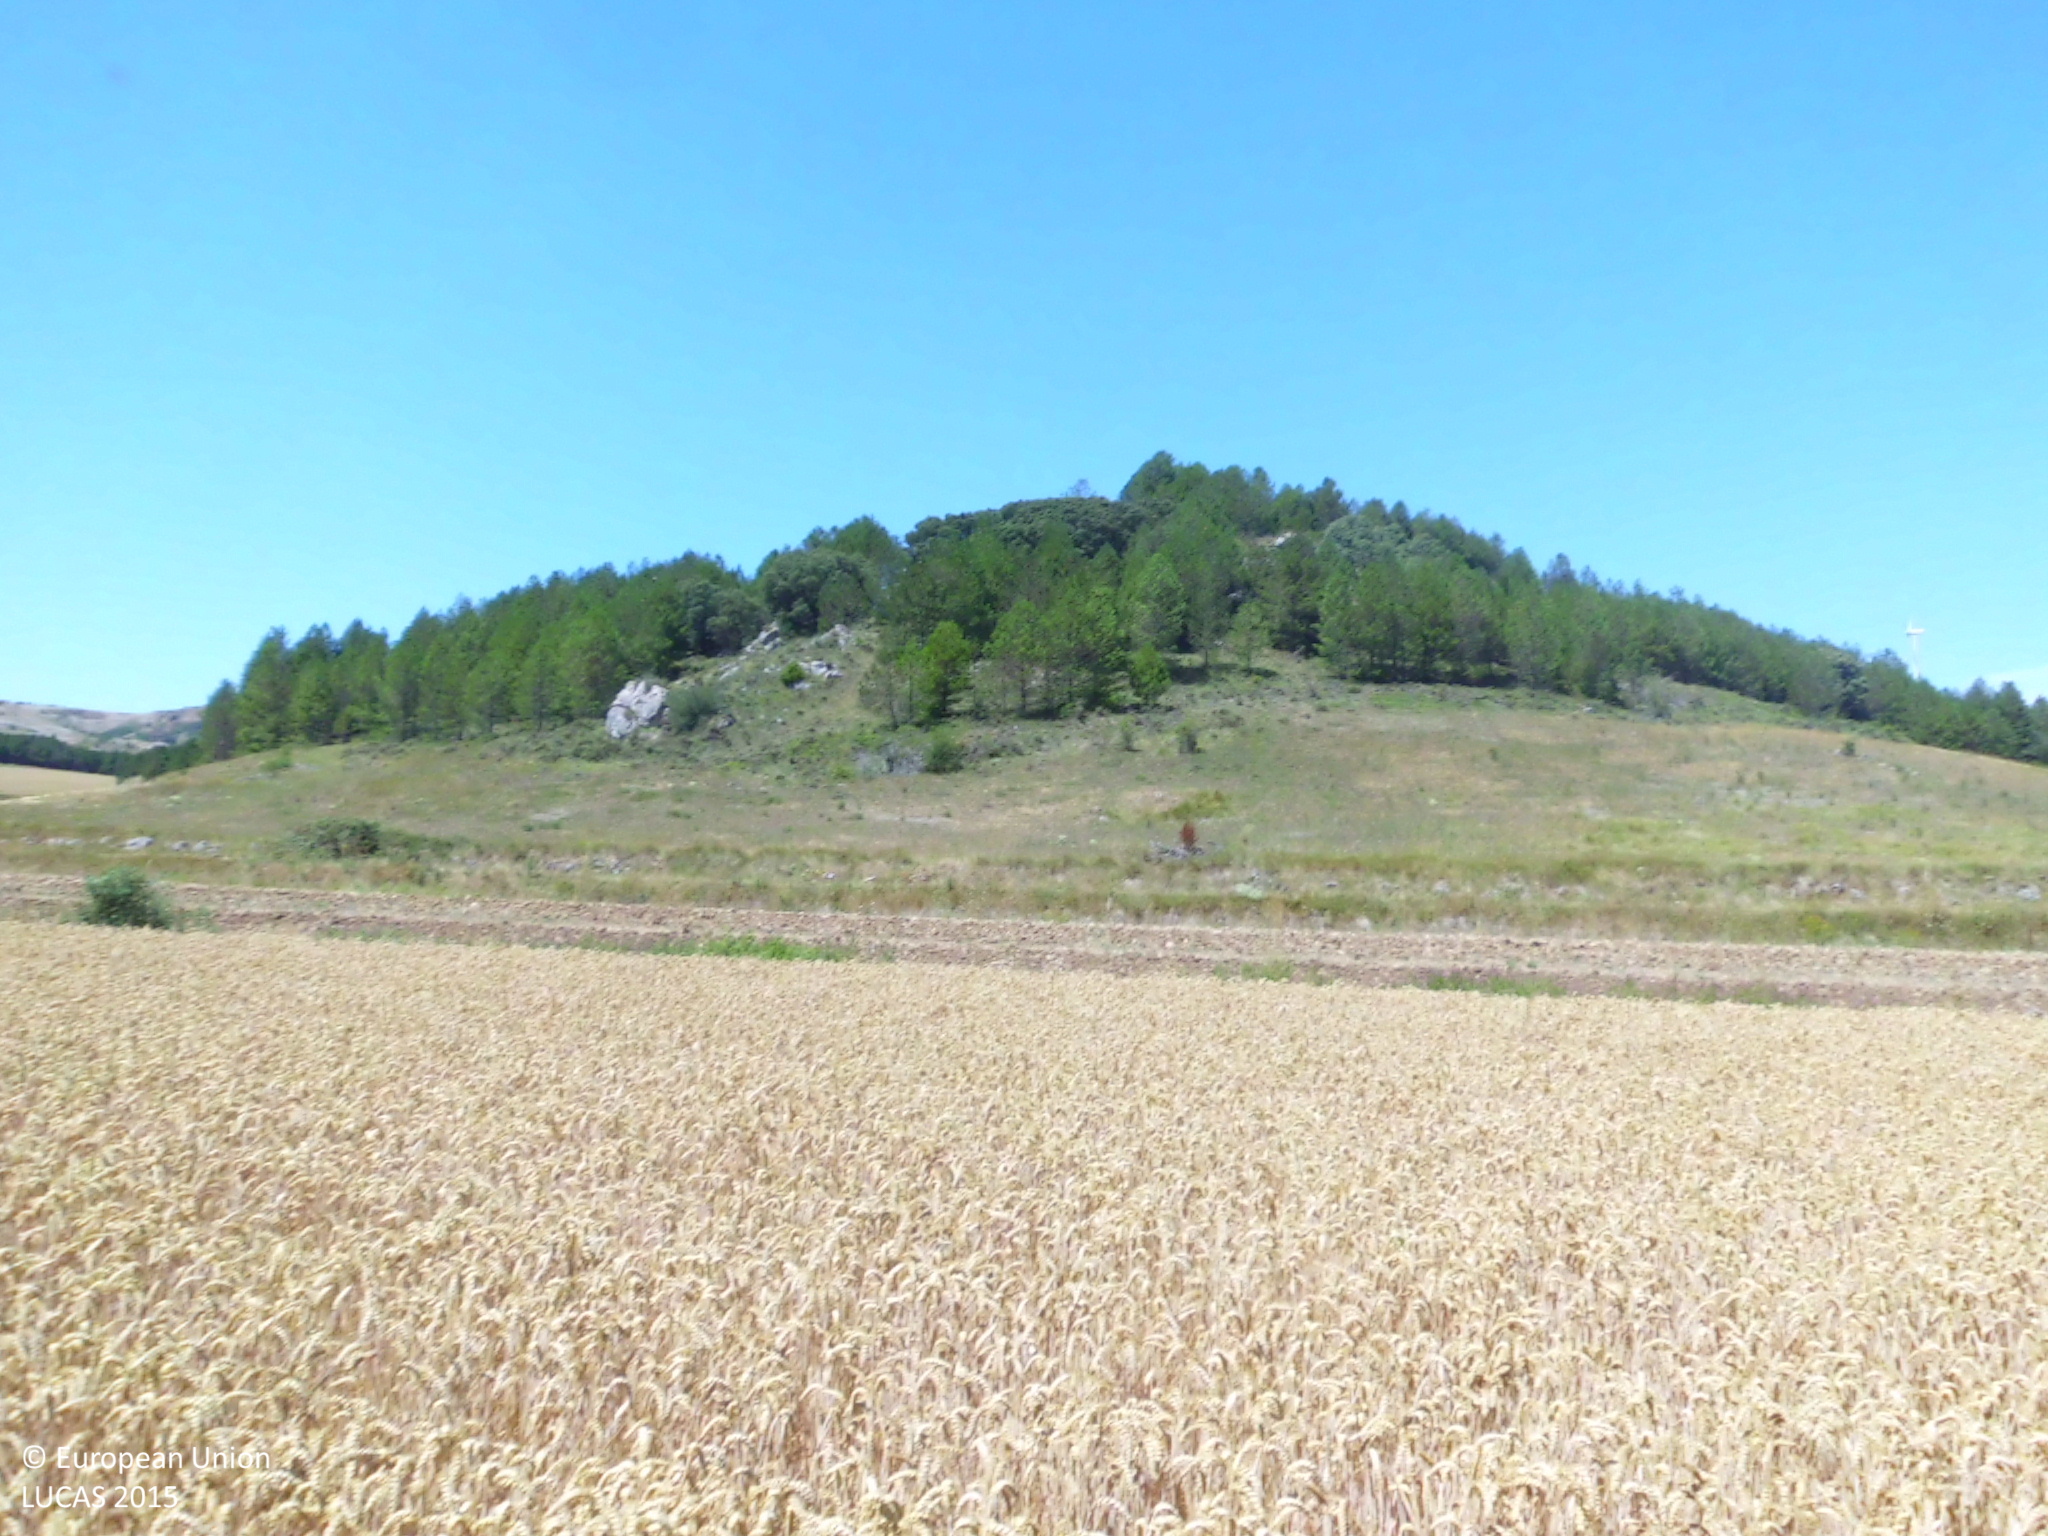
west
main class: Cropland
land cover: Common wheat
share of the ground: > 75 %
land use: Agriculture (excluding fallow land and kitchen gardens)
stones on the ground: < 10 %
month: July
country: ES
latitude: 42.7457
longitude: -4.3319
